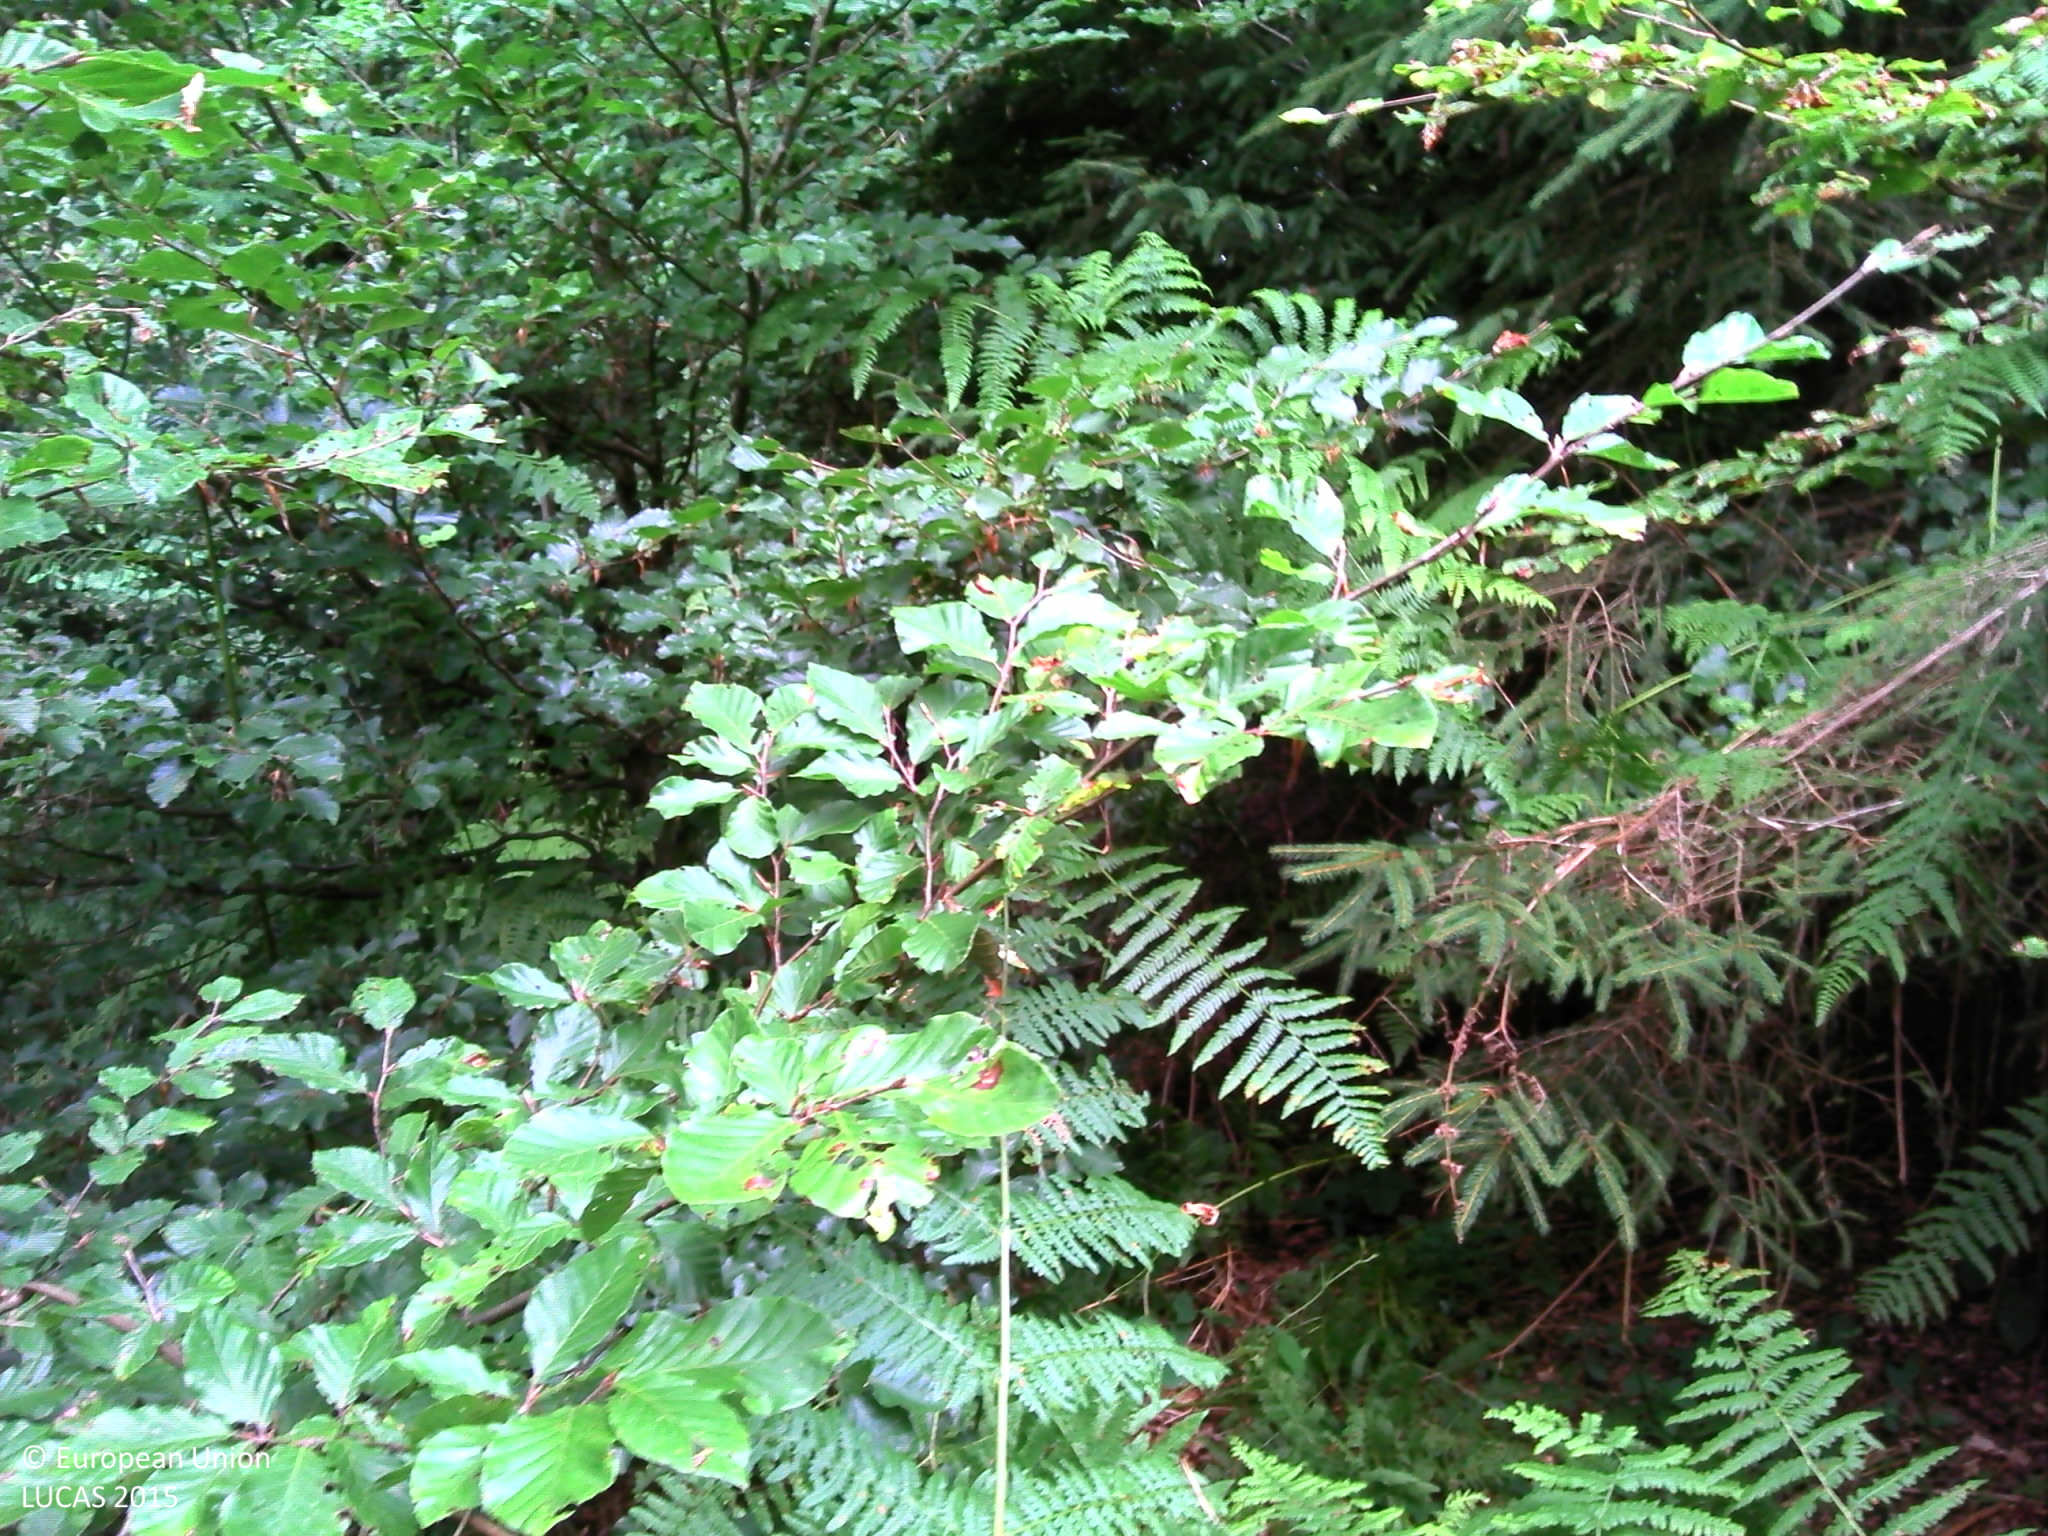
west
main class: Woodland
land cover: Broadleaved woodland
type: beech forest
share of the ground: 50 - 75 %
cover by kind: broadleaved forest trees 70 %, herbaceous plants 30 %
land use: Forestry
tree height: > 5 m
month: July
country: BE
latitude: 49.6146
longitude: 5.6390
